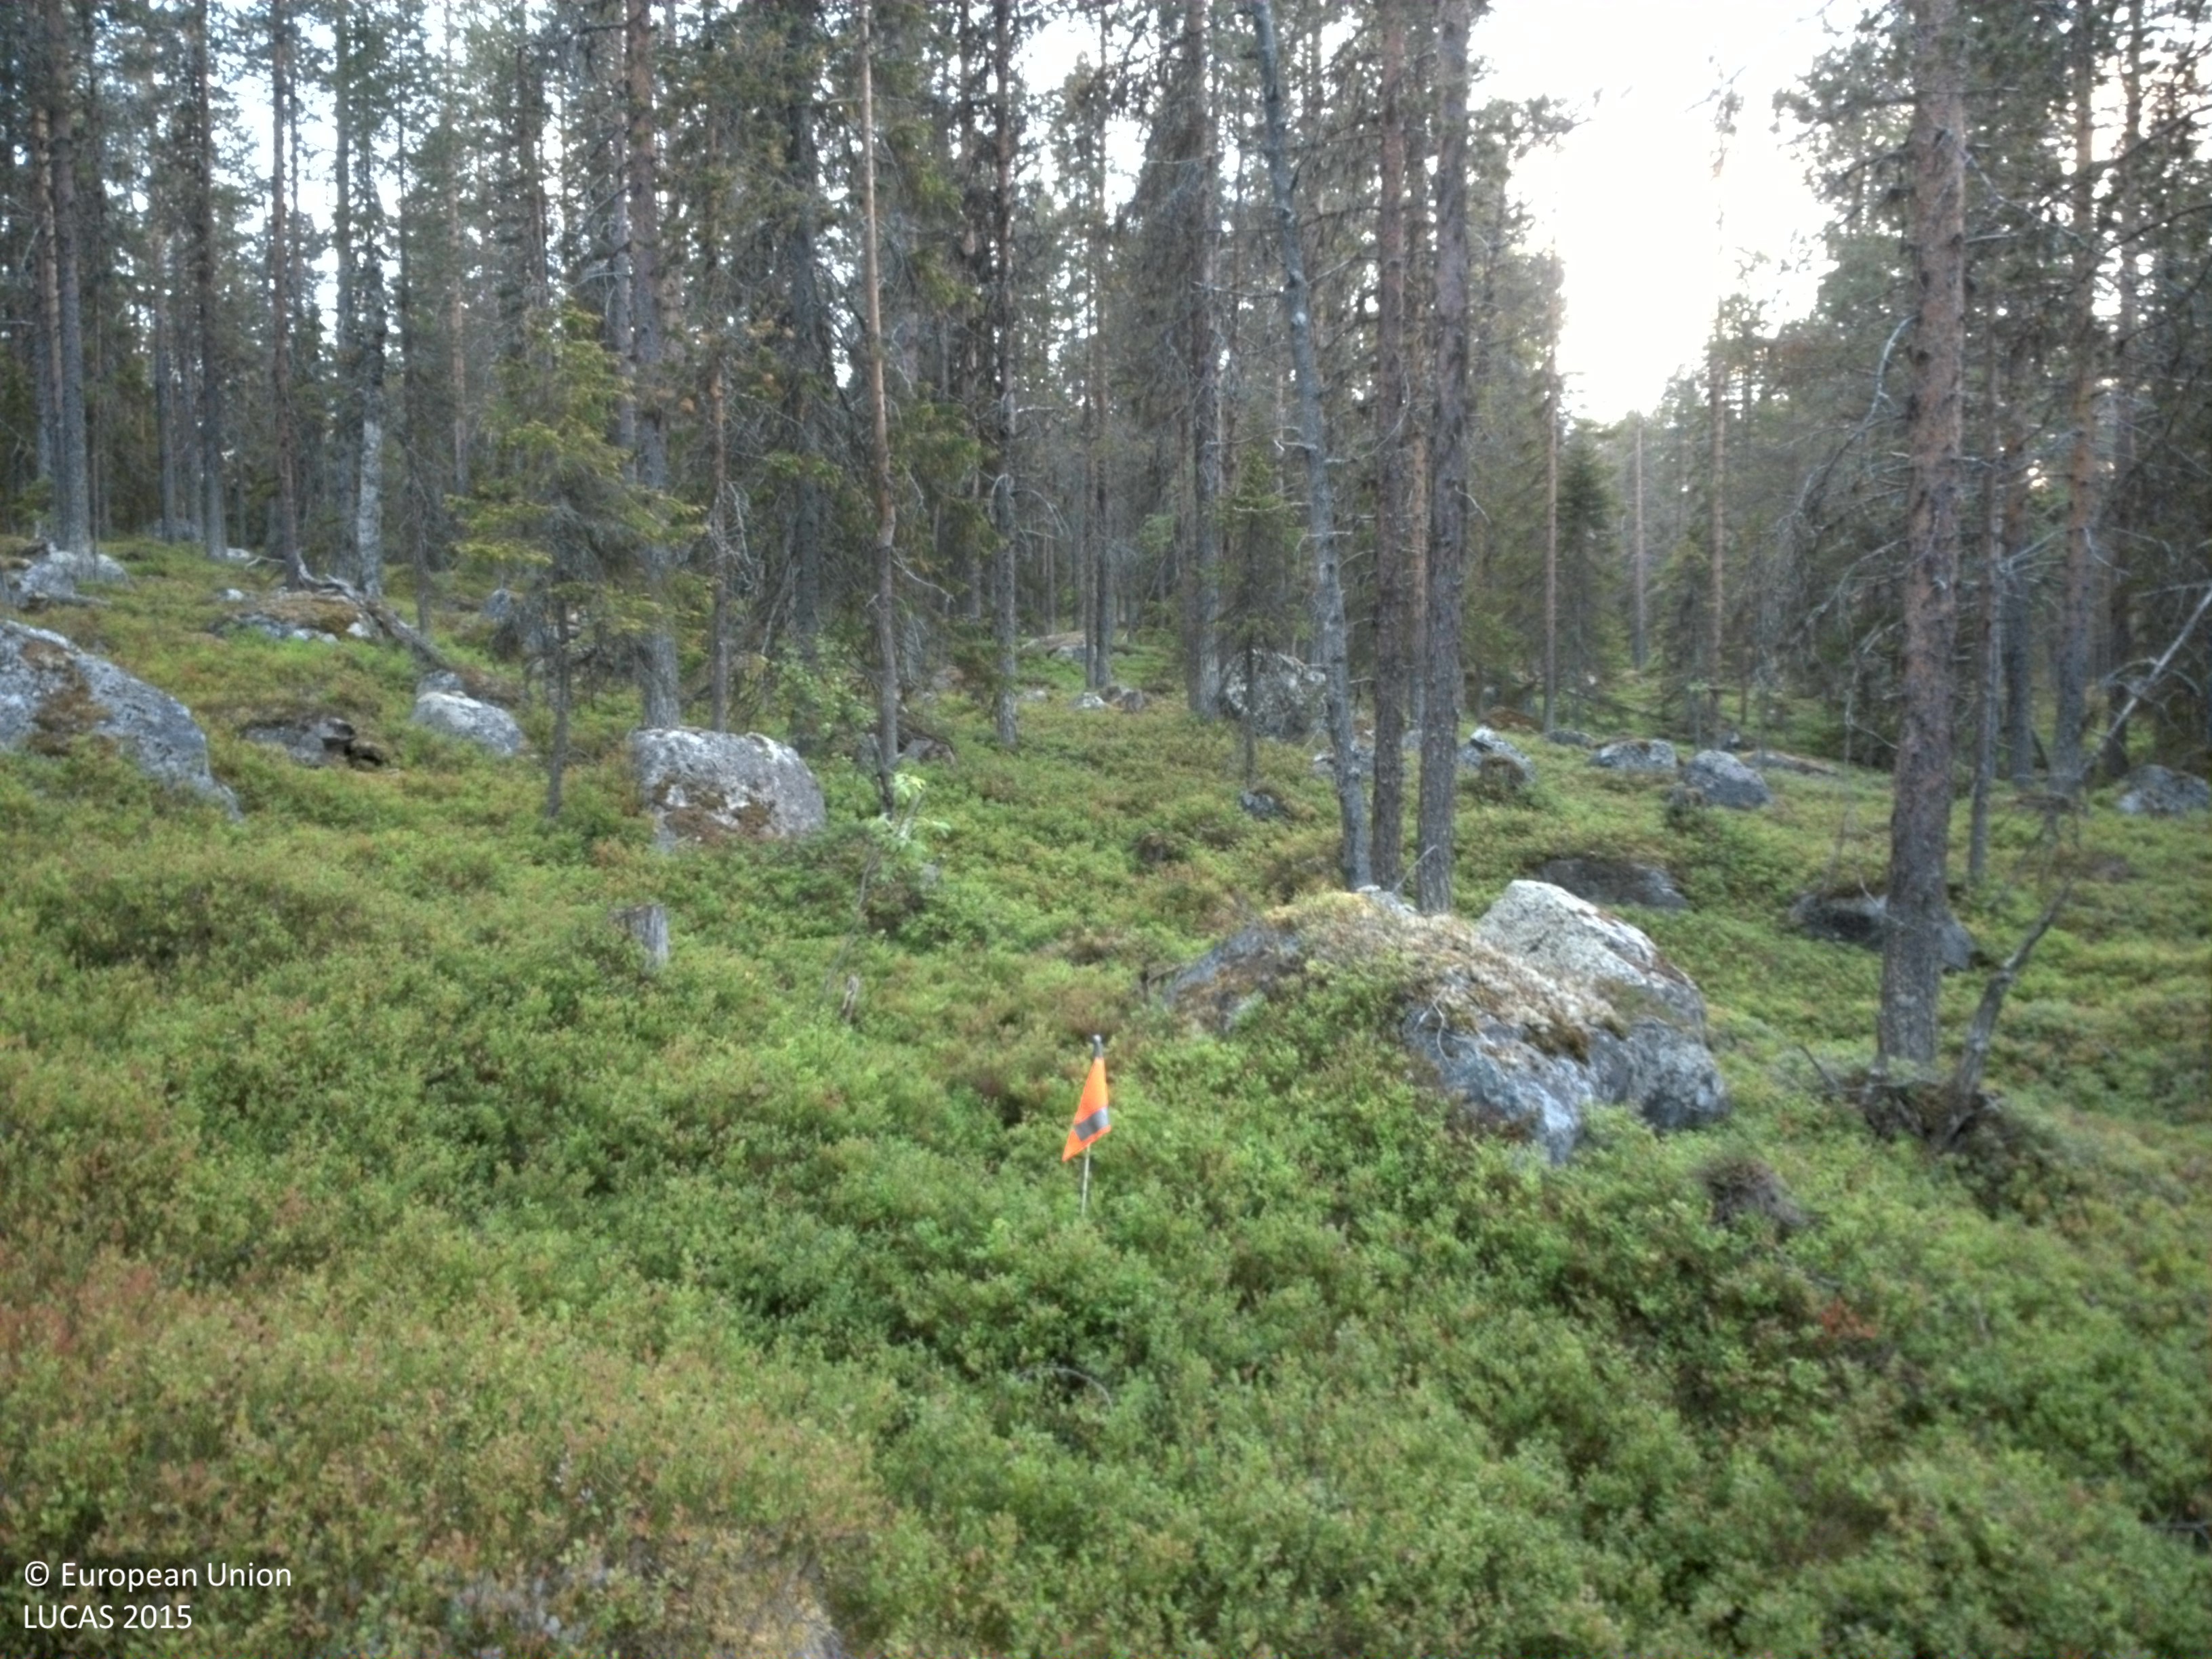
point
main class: Woodland
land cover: Pine dominated coniferous woodland
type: boreal forest
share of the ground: 10 - 25 %
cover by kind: shrubs 65 %, coniferous forest trees 20 %, lichens and mosses 10 %, consolidated bare surface 5 %
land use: Forestry
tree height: > 5 m
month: September
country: SE
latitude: 65.1613
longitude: 17.5791
